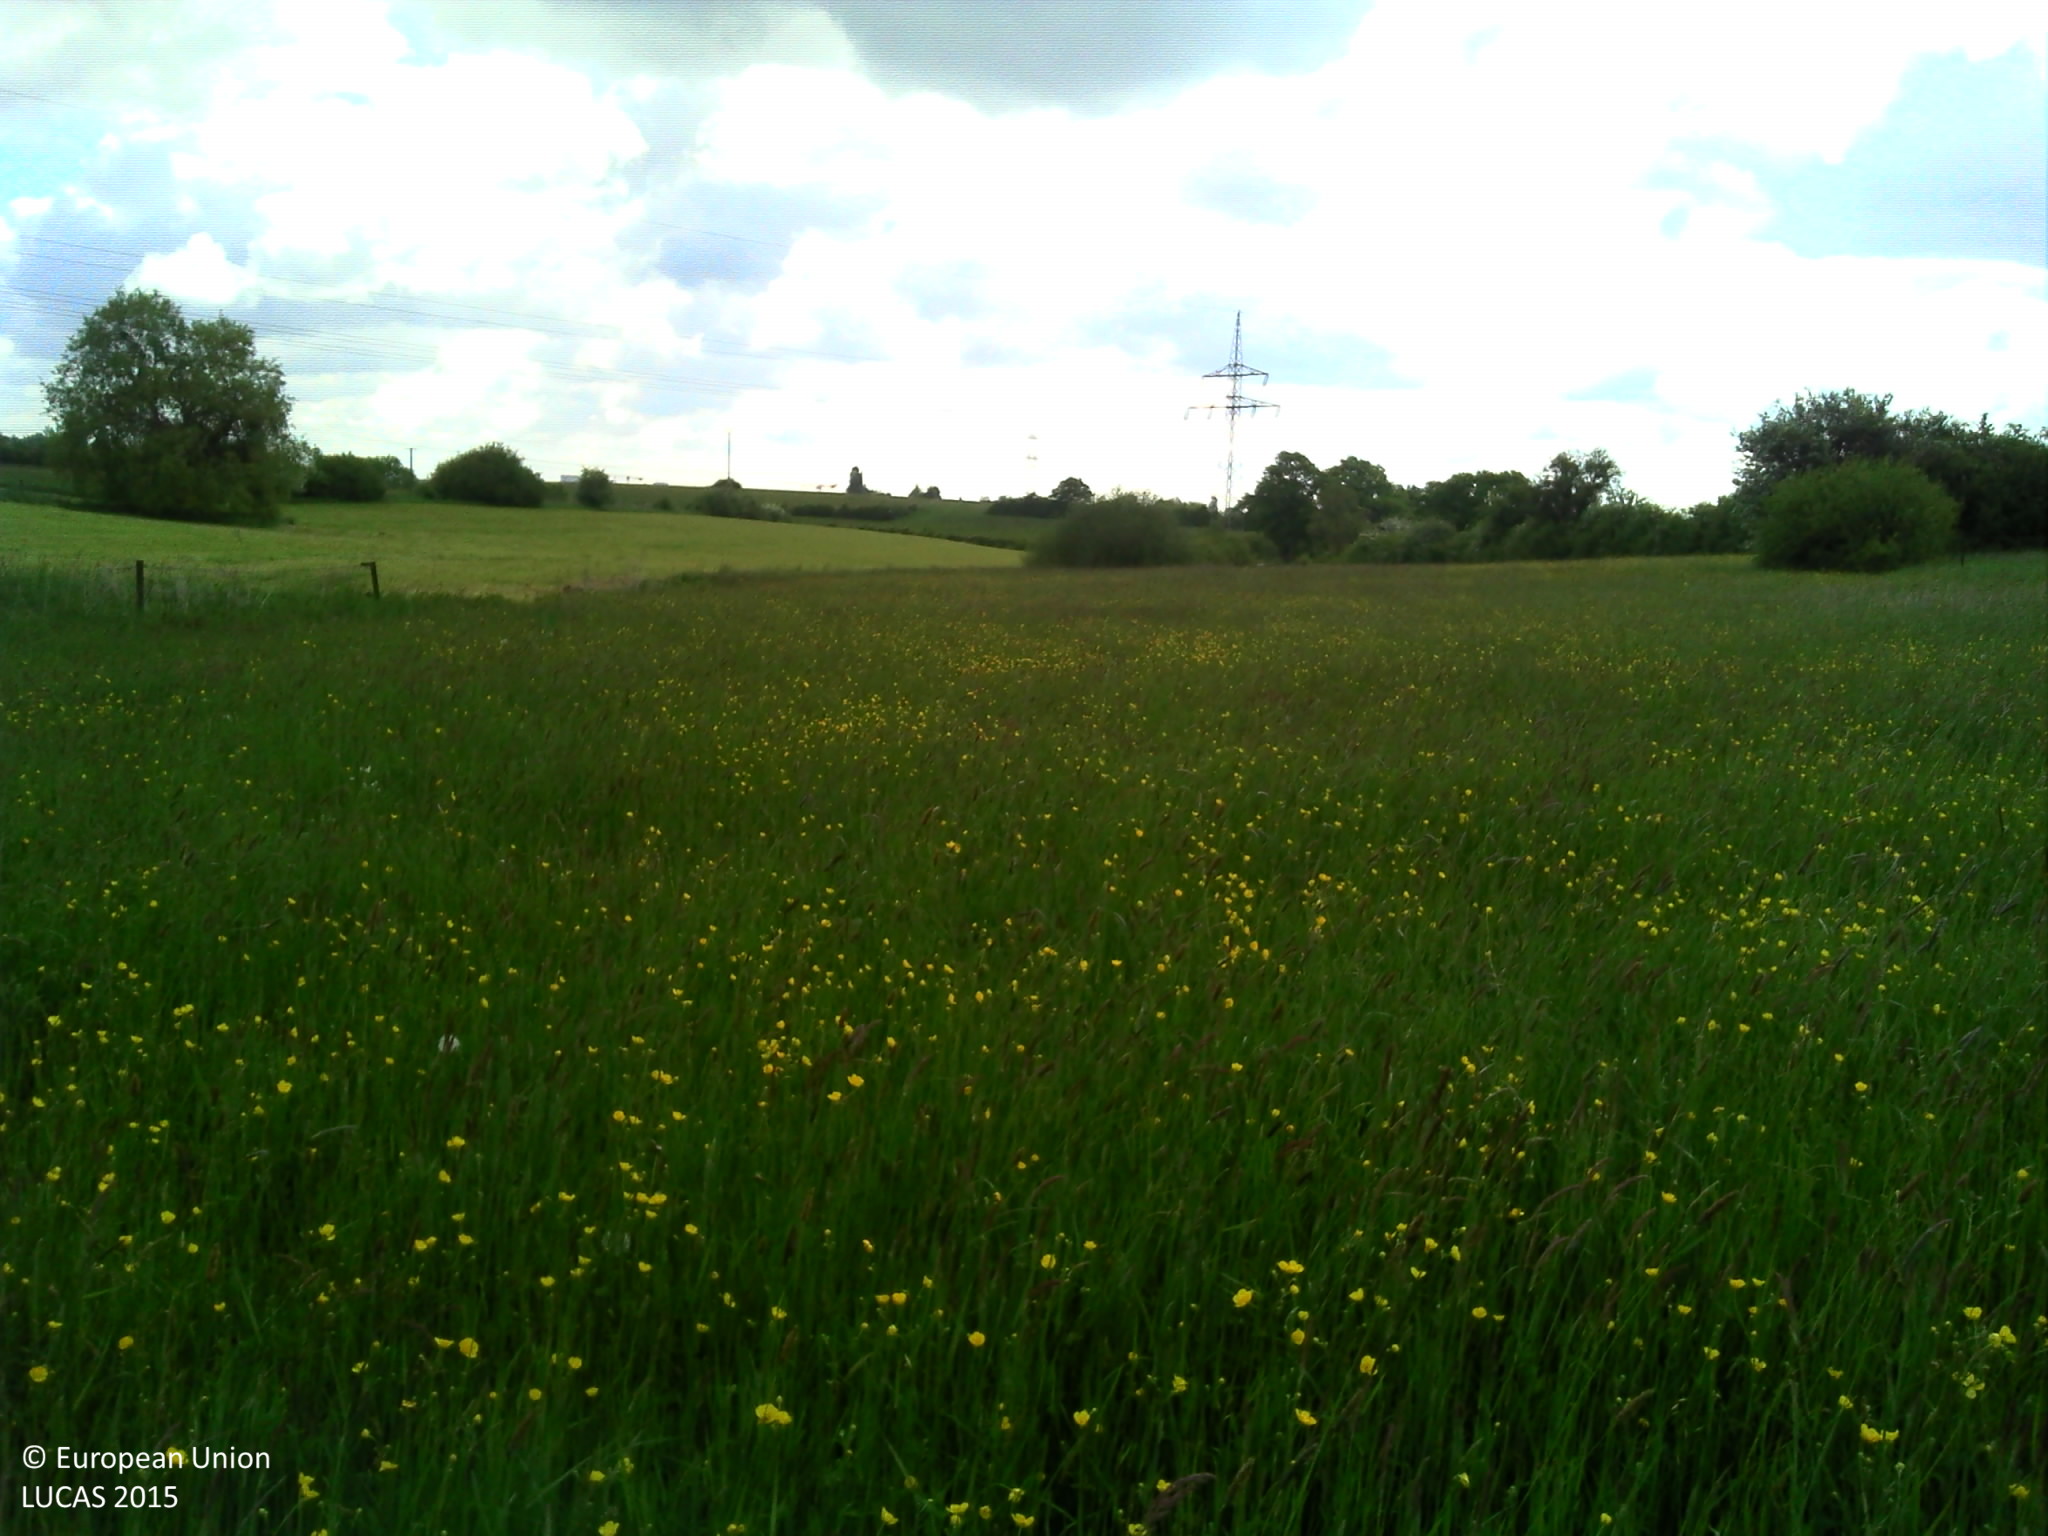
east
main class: Grassland
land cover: Grassland without tree/shrub cover
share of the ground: > 75 %
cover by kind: herbaceous plants 100 %
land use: Agriculture (excluding fallow land and kitchen gardens)
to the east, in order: Grassland without tree/shrub cover; Ditches and canals; Grassland without tree/shrub cover; Electric lines; Grassland without tree/shrub cover
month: May
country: LU
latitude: 49.6109
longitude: 6.0274
